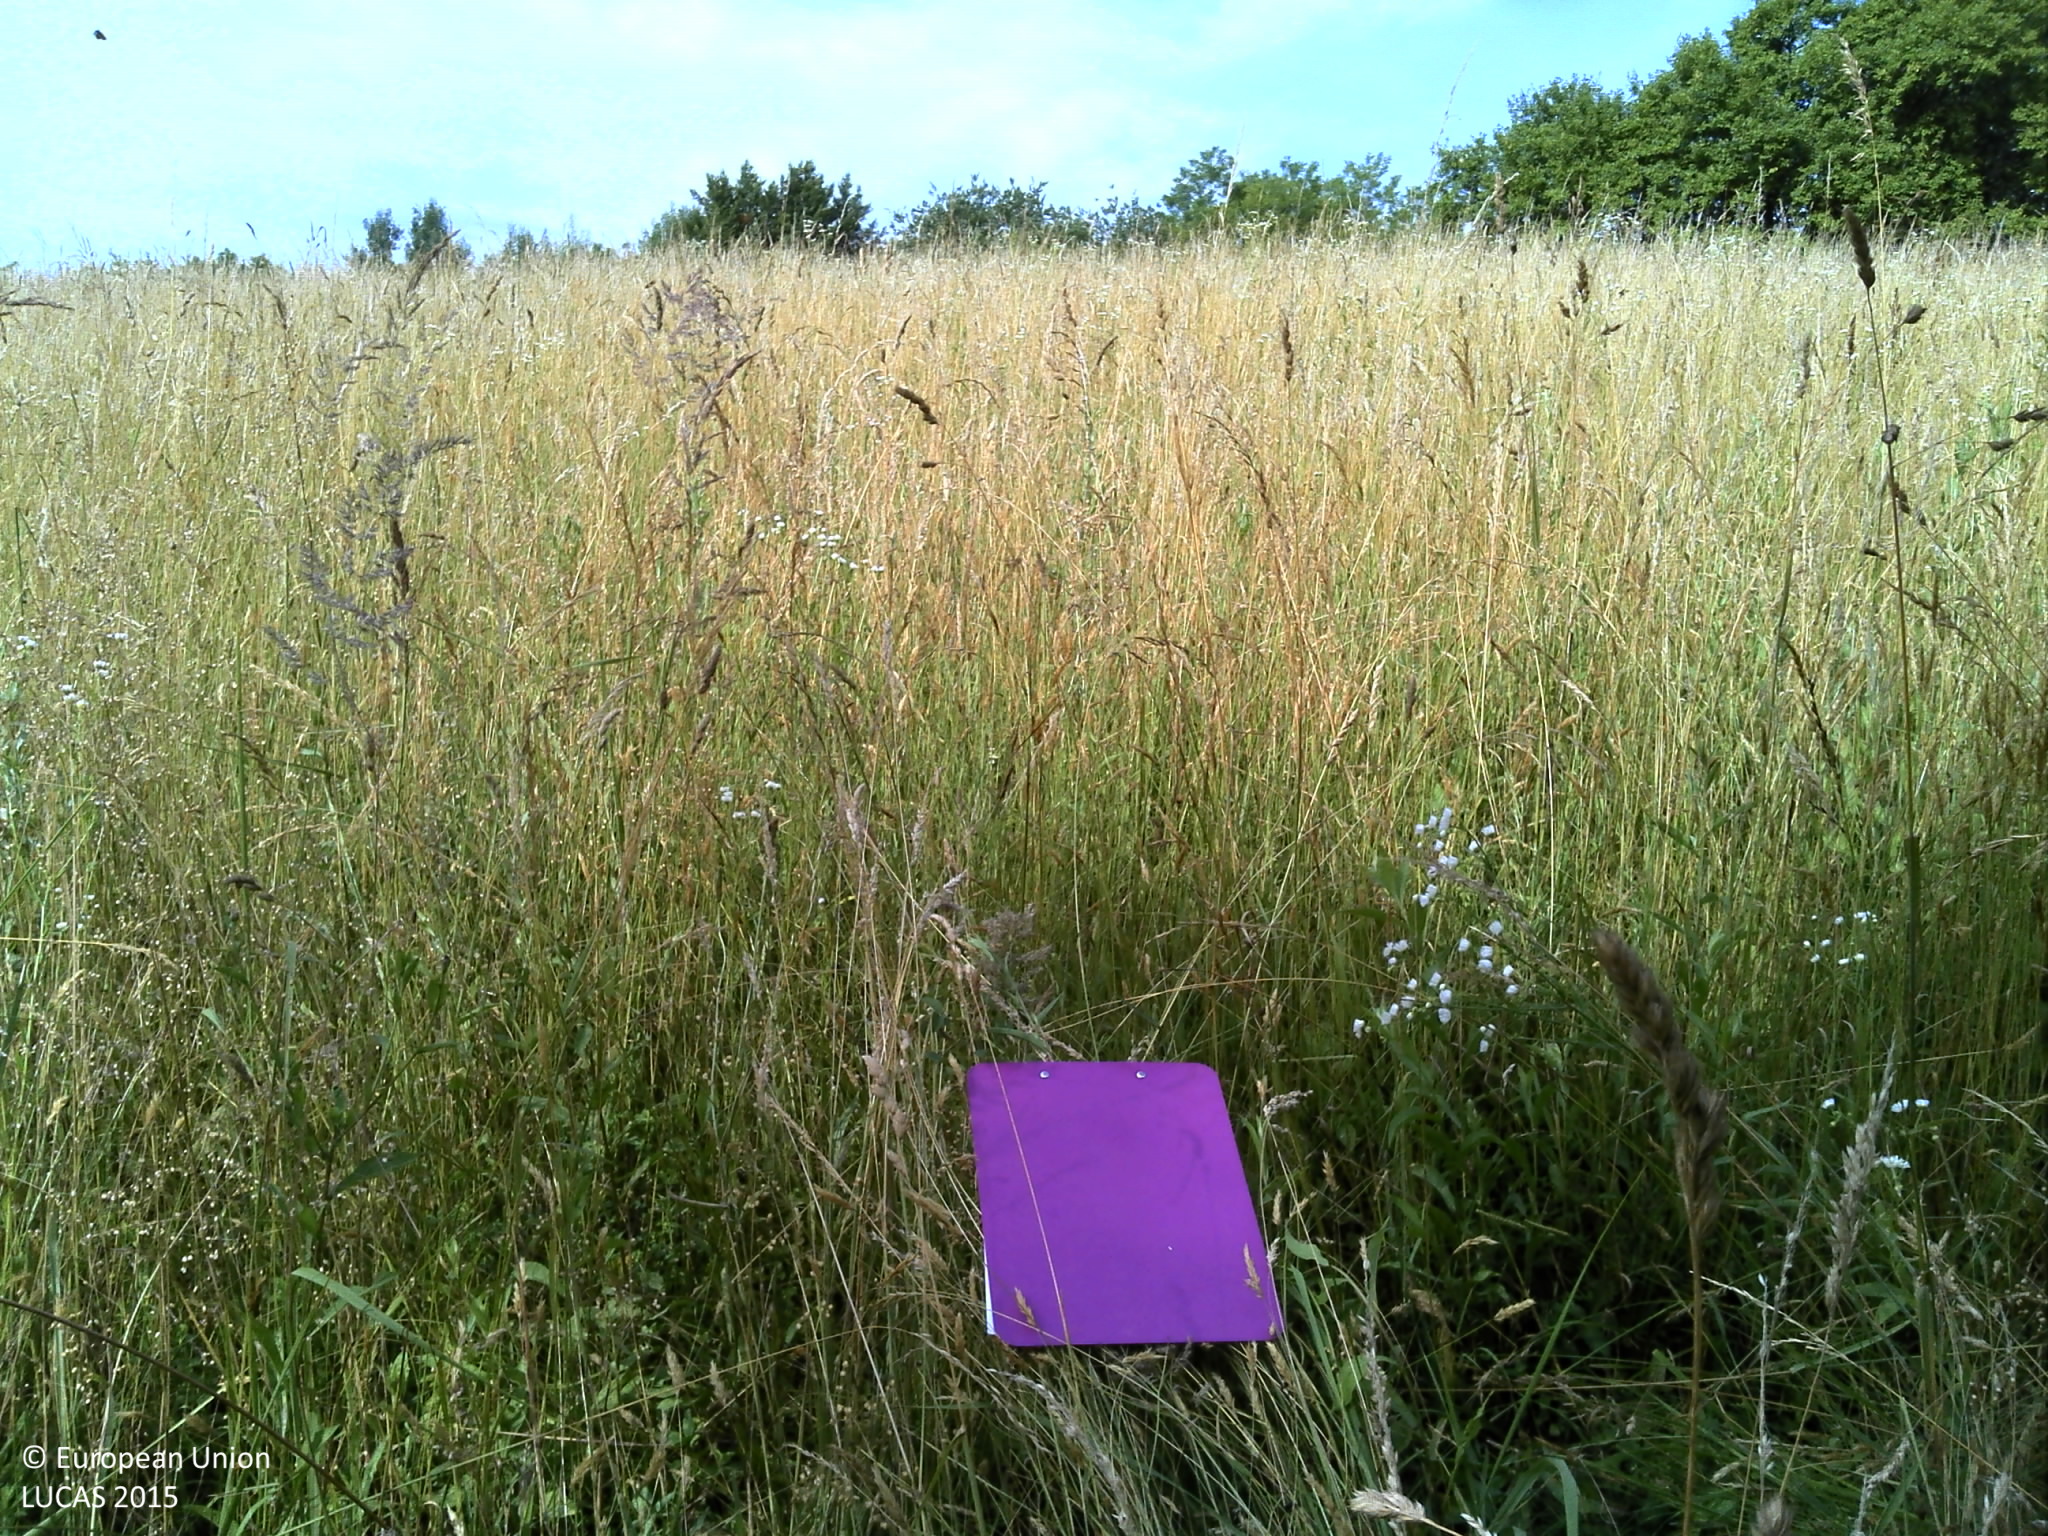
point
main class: Grassland
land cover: Spontaneously vegetated surfaces
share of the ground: > 75 %
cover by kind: herbaceous plants 100 %
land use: Semi-natural and natural areas not in use
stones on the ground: < 10 %
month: June
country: HR
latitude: 45.7425
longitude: 17.5214
